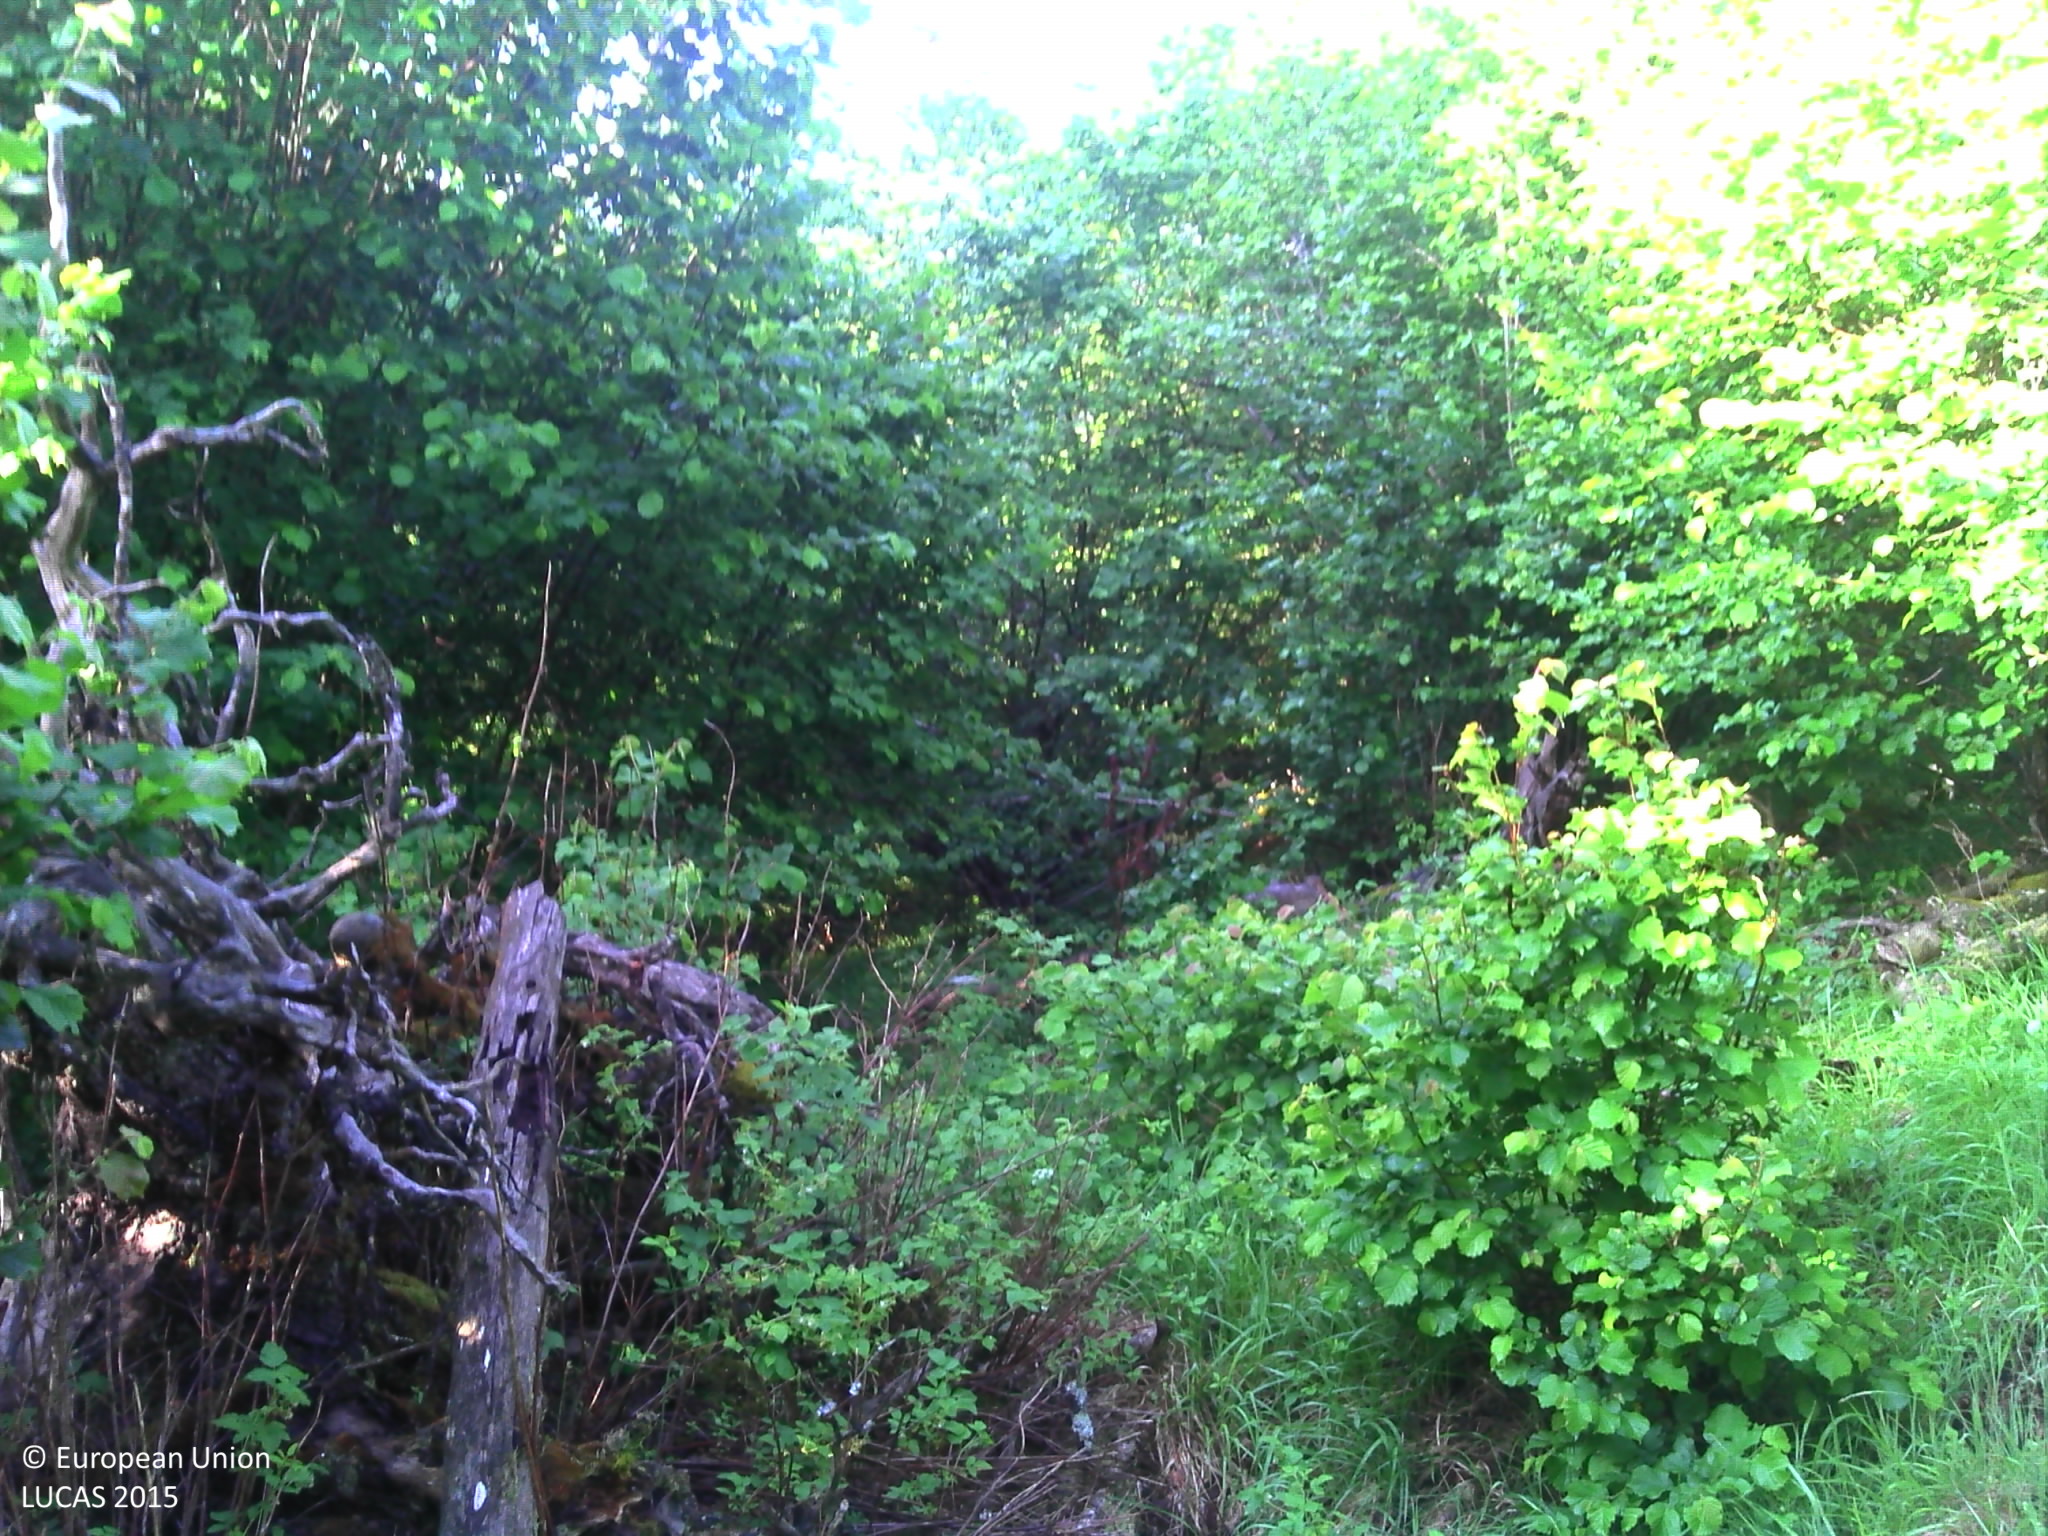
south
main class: Woodland
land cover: Pine dominated mixed woodland
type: alpine coniferous forest
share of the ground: > 75 %
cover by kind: broadleaved forest trees 50 %, coniferous forest trees 20 %, herbaceous plants 20 %, shrubs 10 %
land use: Forestry
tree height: > 5 m
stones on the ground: 10 - 25 %
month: June
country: FR
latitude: 45.1757
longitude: 2.9135
